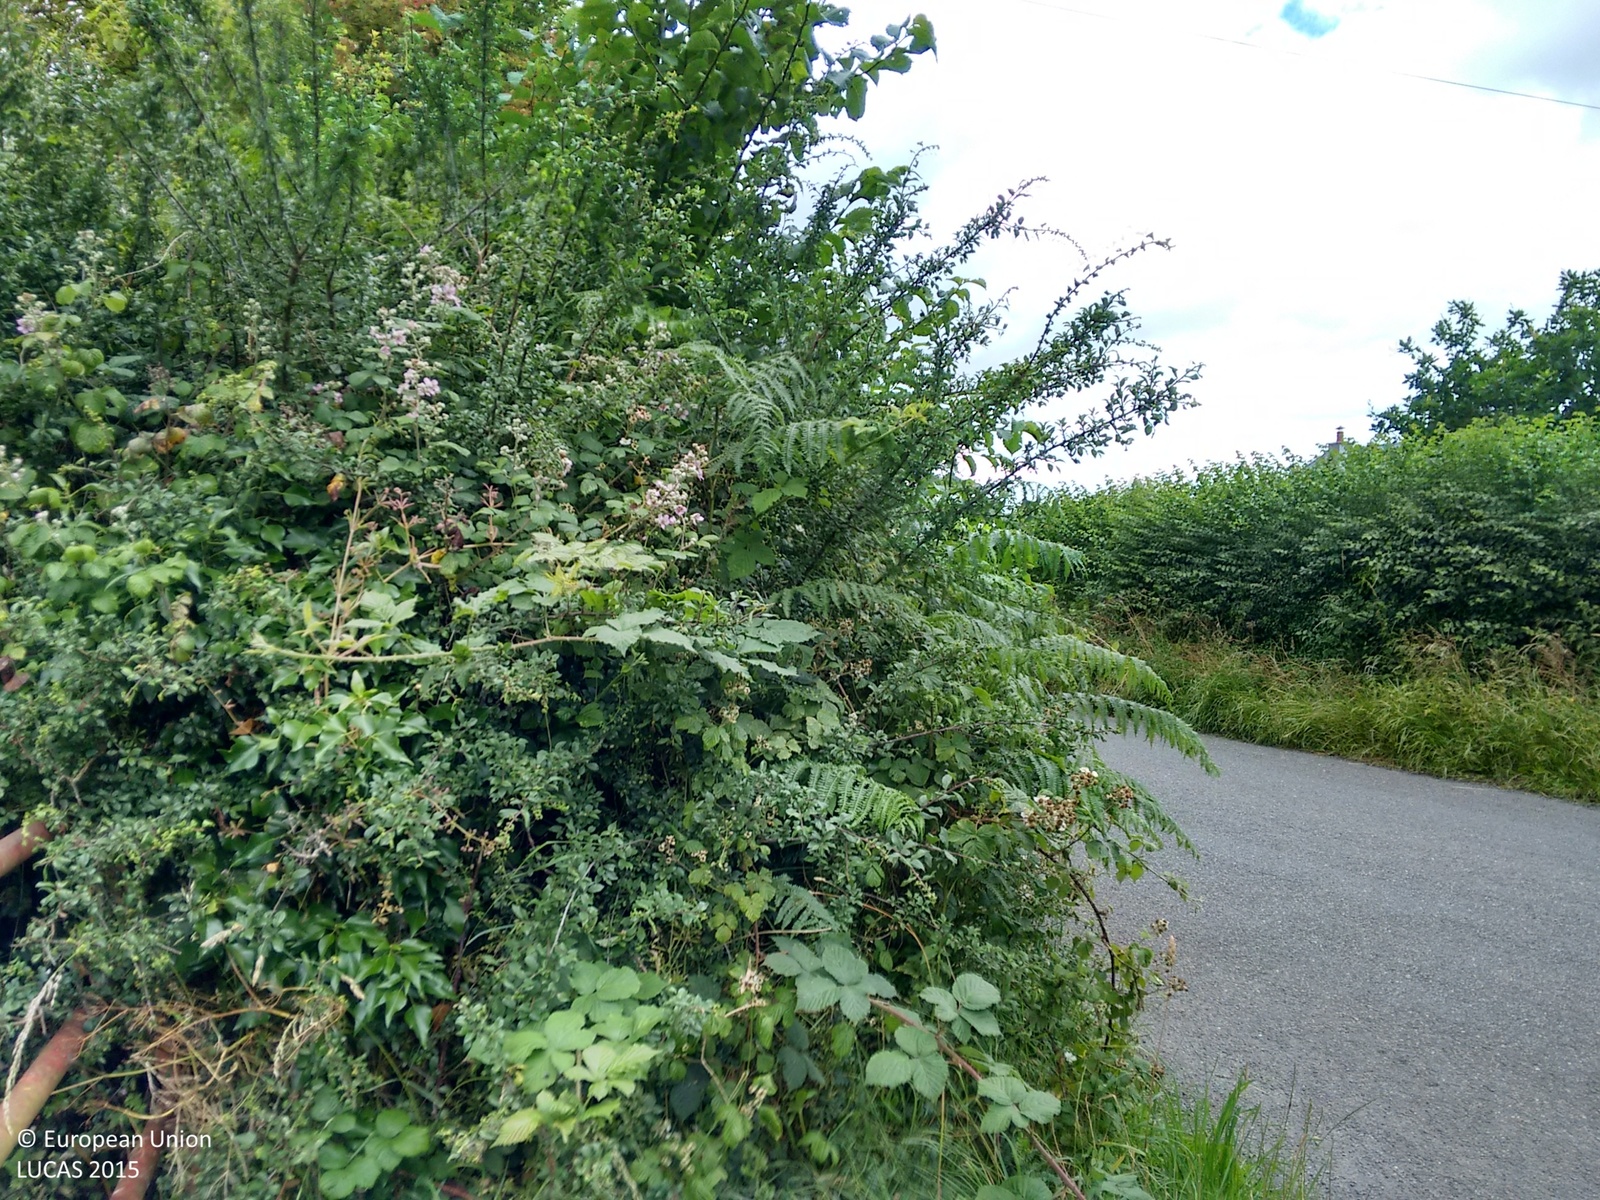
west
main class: Grassland
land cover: Grassland without tree/shrub cover
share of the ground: > 75 %
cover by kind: herbaceous plants 100 %
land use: Agriculture (excluding fallow land and kitchen gardens)
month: July
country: IE
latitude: 52.7164
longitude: -7.2795
